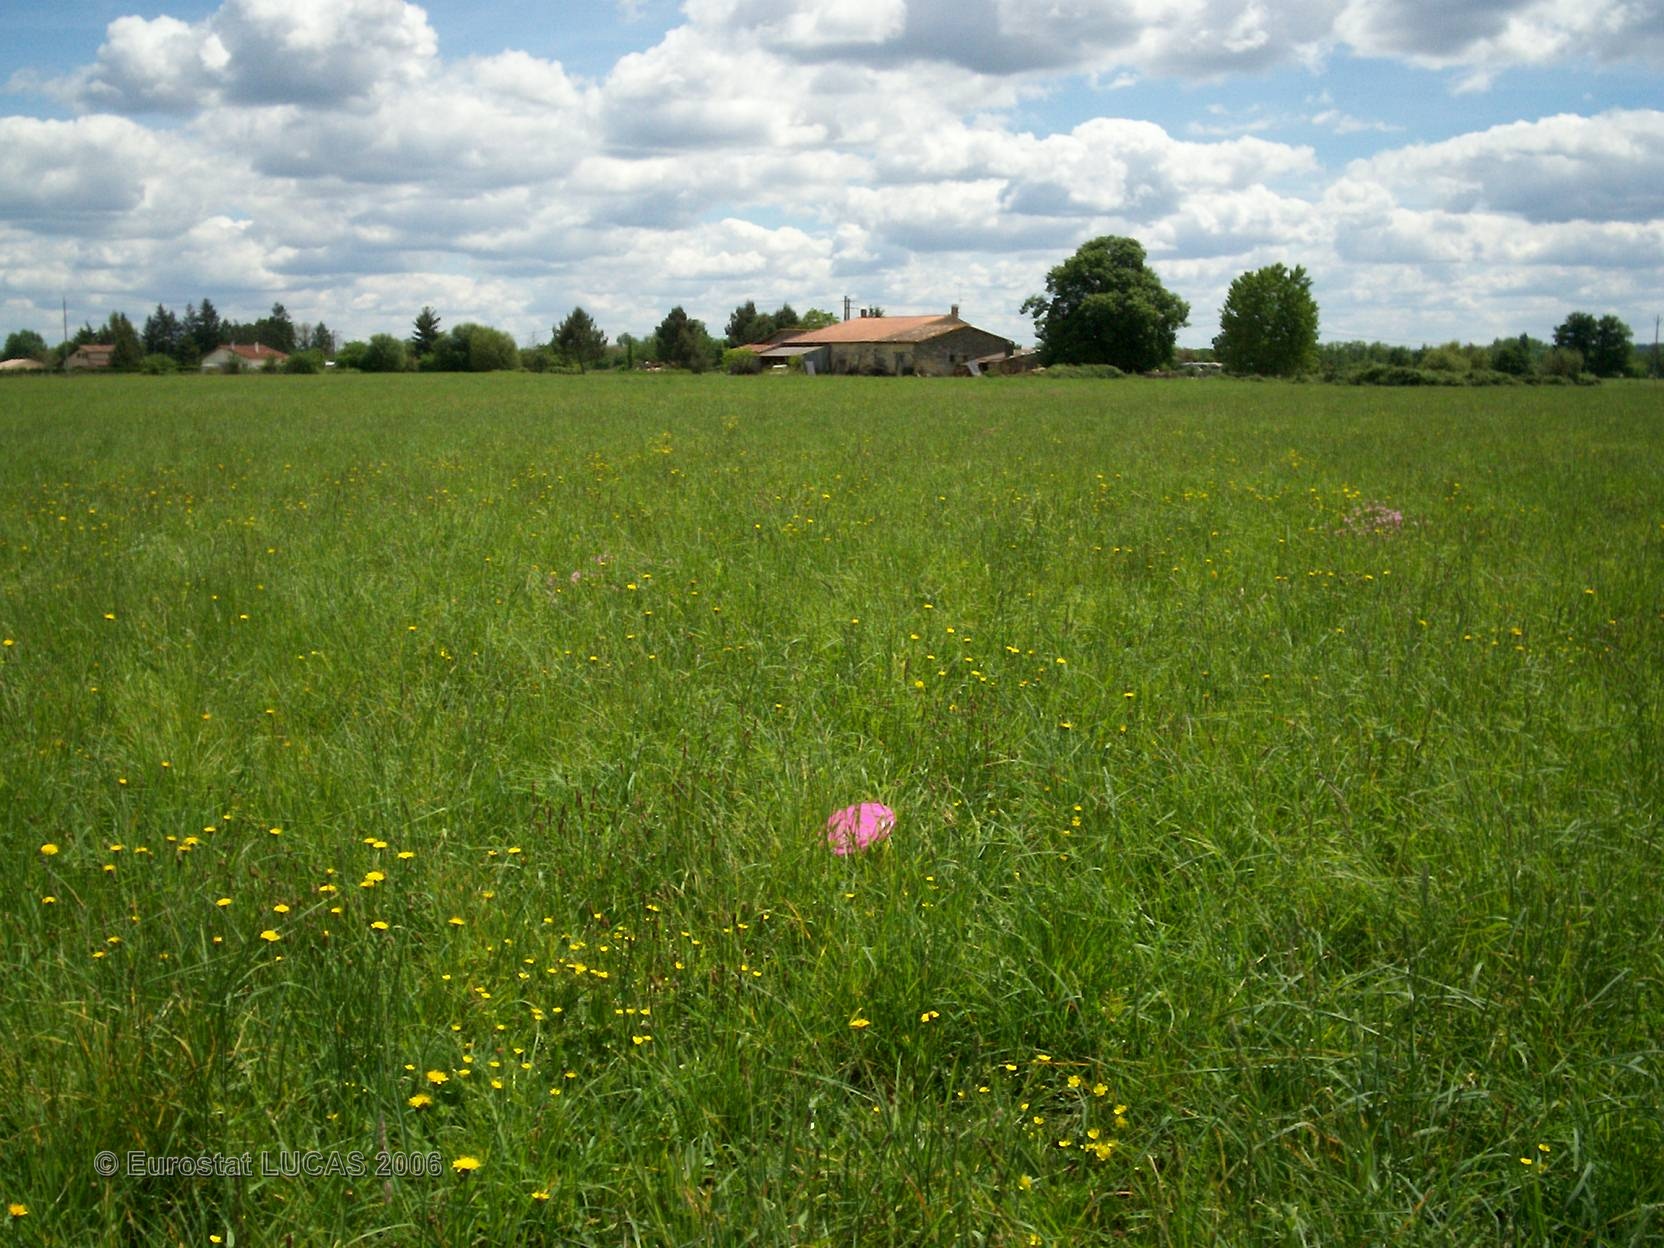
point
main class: Grassland
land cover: Grassland without tree/shrub cover
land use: Agriculture (excluding fallow land and kitchen gardens)
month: May
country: FR
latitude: 45.0282
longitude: -0.0032
